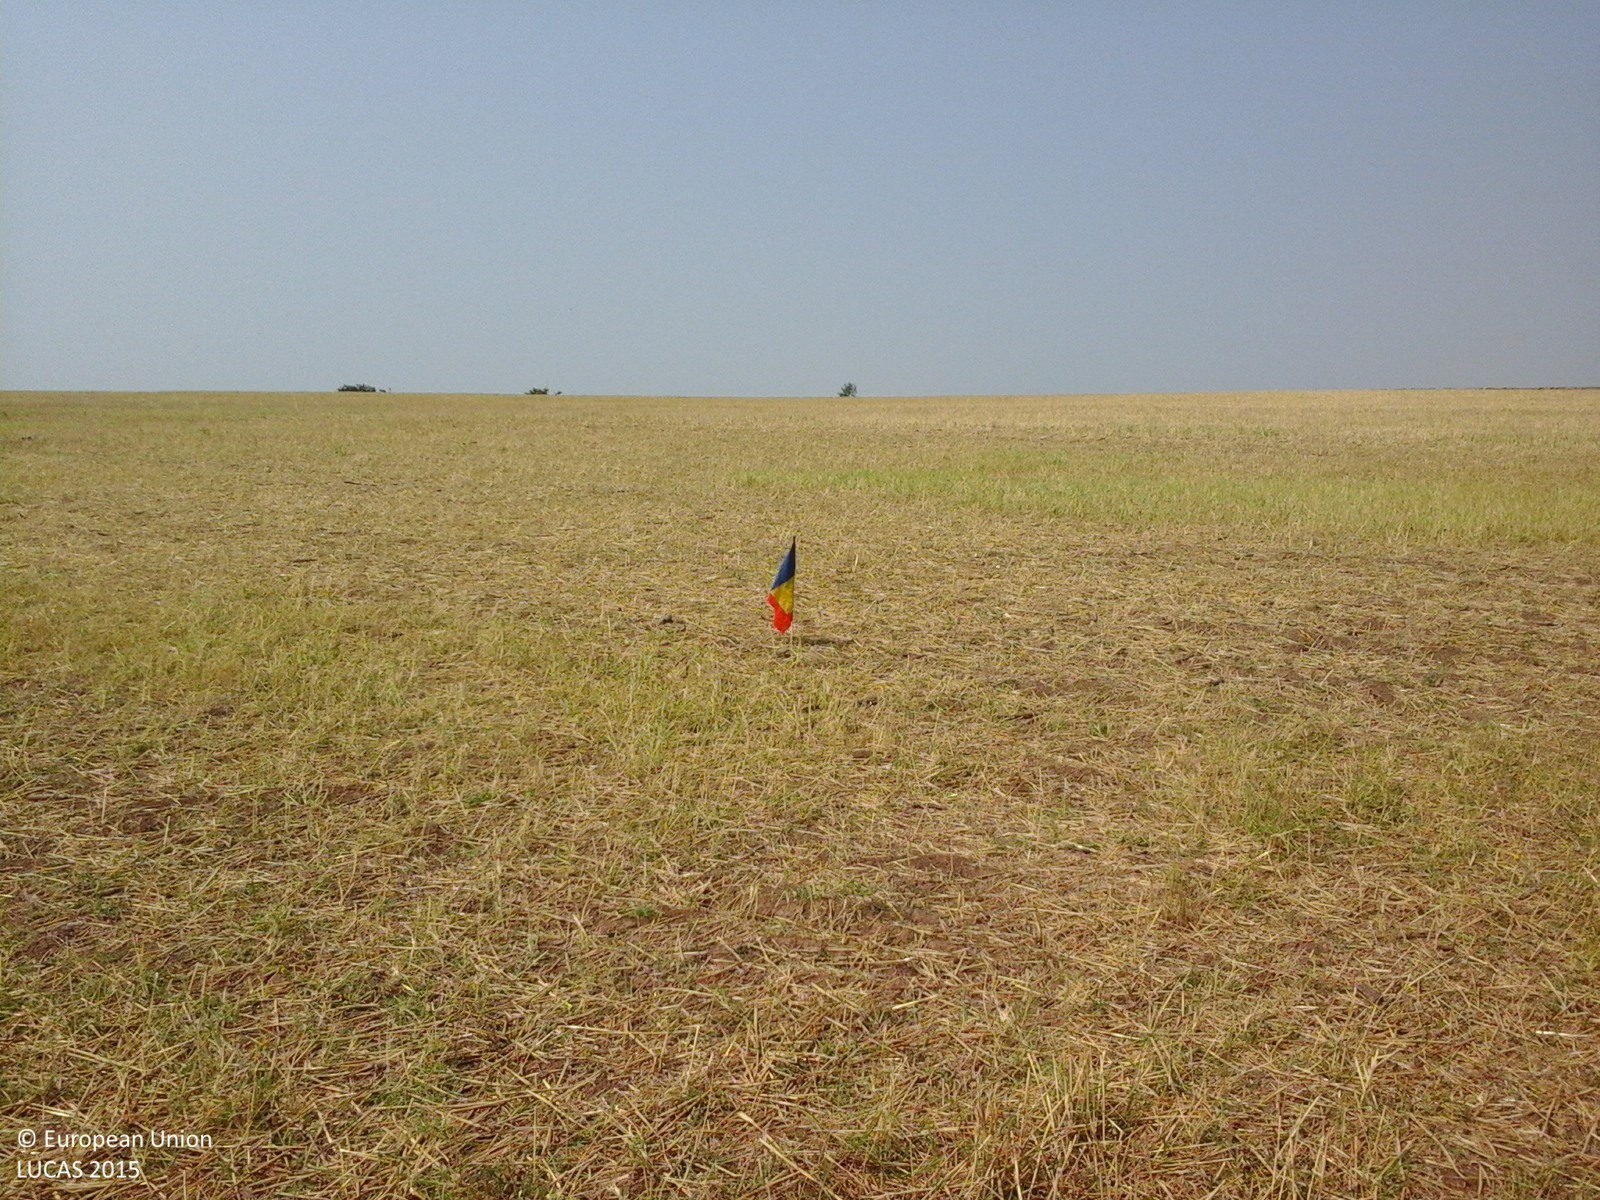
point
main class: Cropland
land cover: Common wheat
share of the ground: 50 - 75 %
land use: Agriculture (excluding fallow land and kitchen gardens)
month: August
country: RO
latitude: 44.3037
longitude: 23.5018
